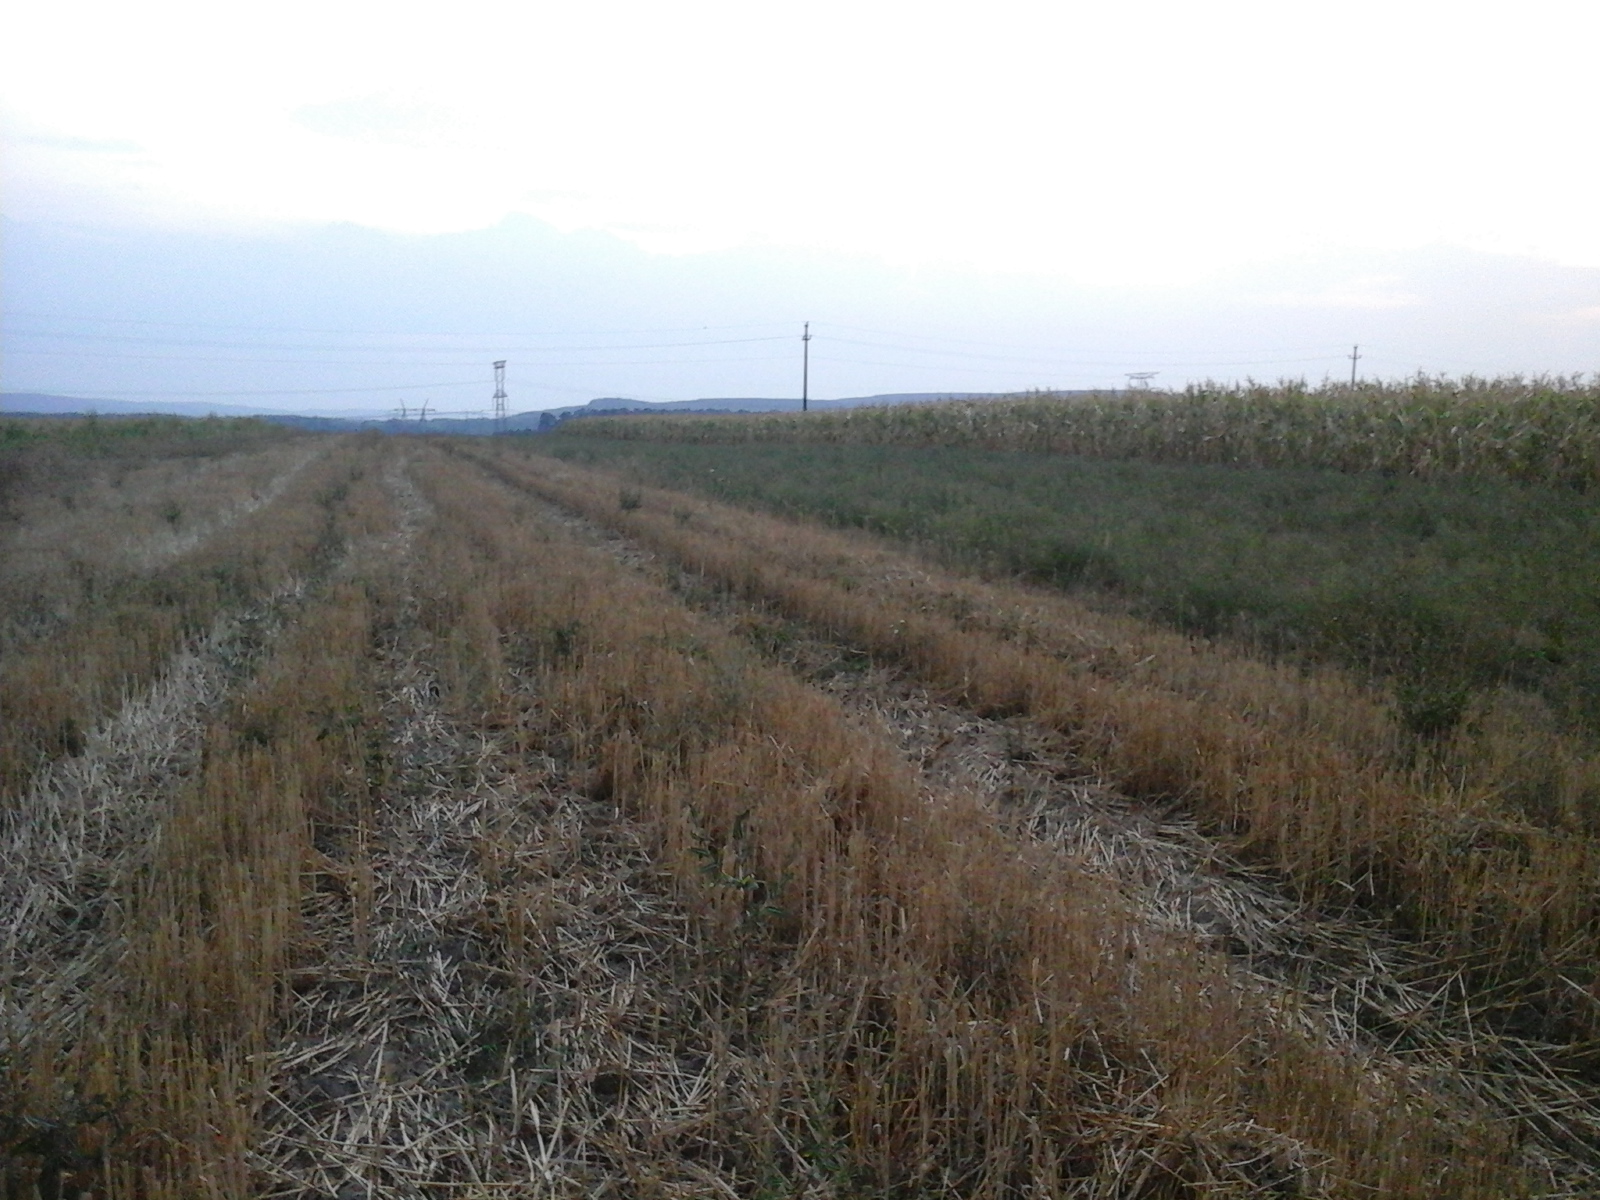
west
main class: Cropland
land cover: Common wheat
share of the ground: > 75 %
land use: Agriculture (excluding fallow land and kitchen gardens)
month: August
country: RO
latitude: 44.5789
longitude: 23.4916
